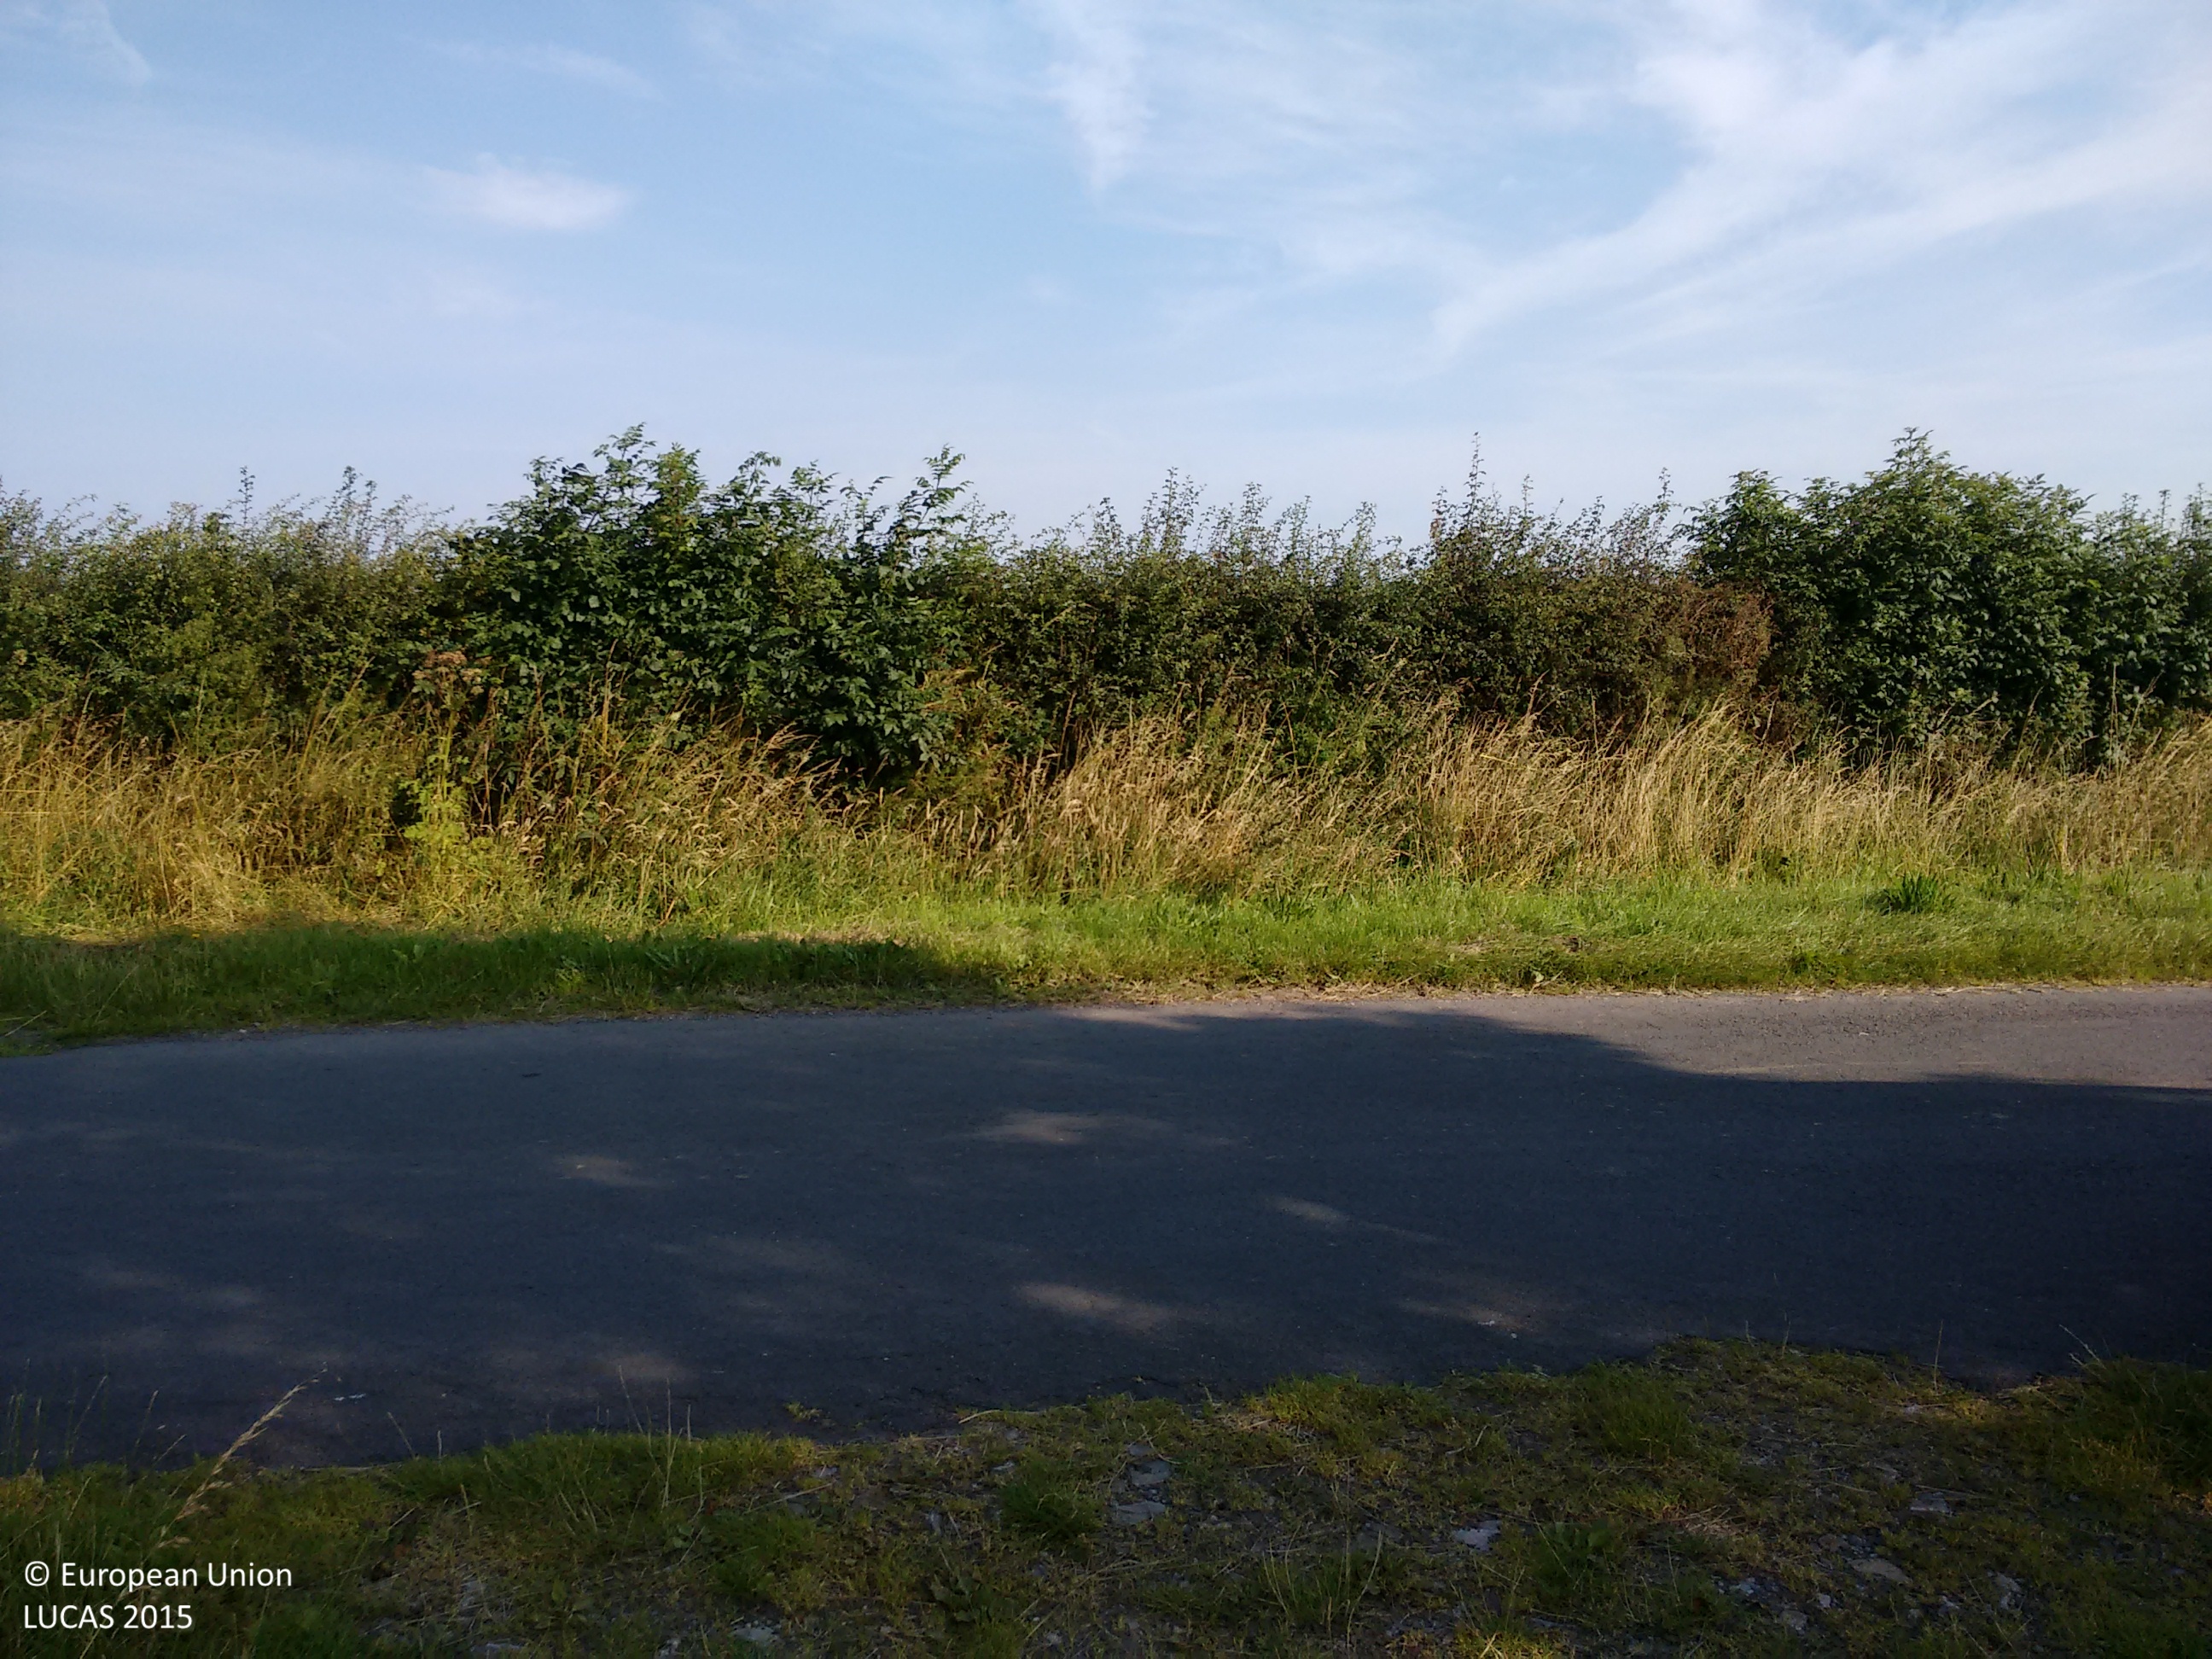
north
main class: Cropland
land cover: Temporary grasslands
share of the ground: > 75 %
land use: Agriculture (excluding fallow land and kitchen gardens)
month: August
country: GB
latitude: 54.8448
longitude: -3.2033
